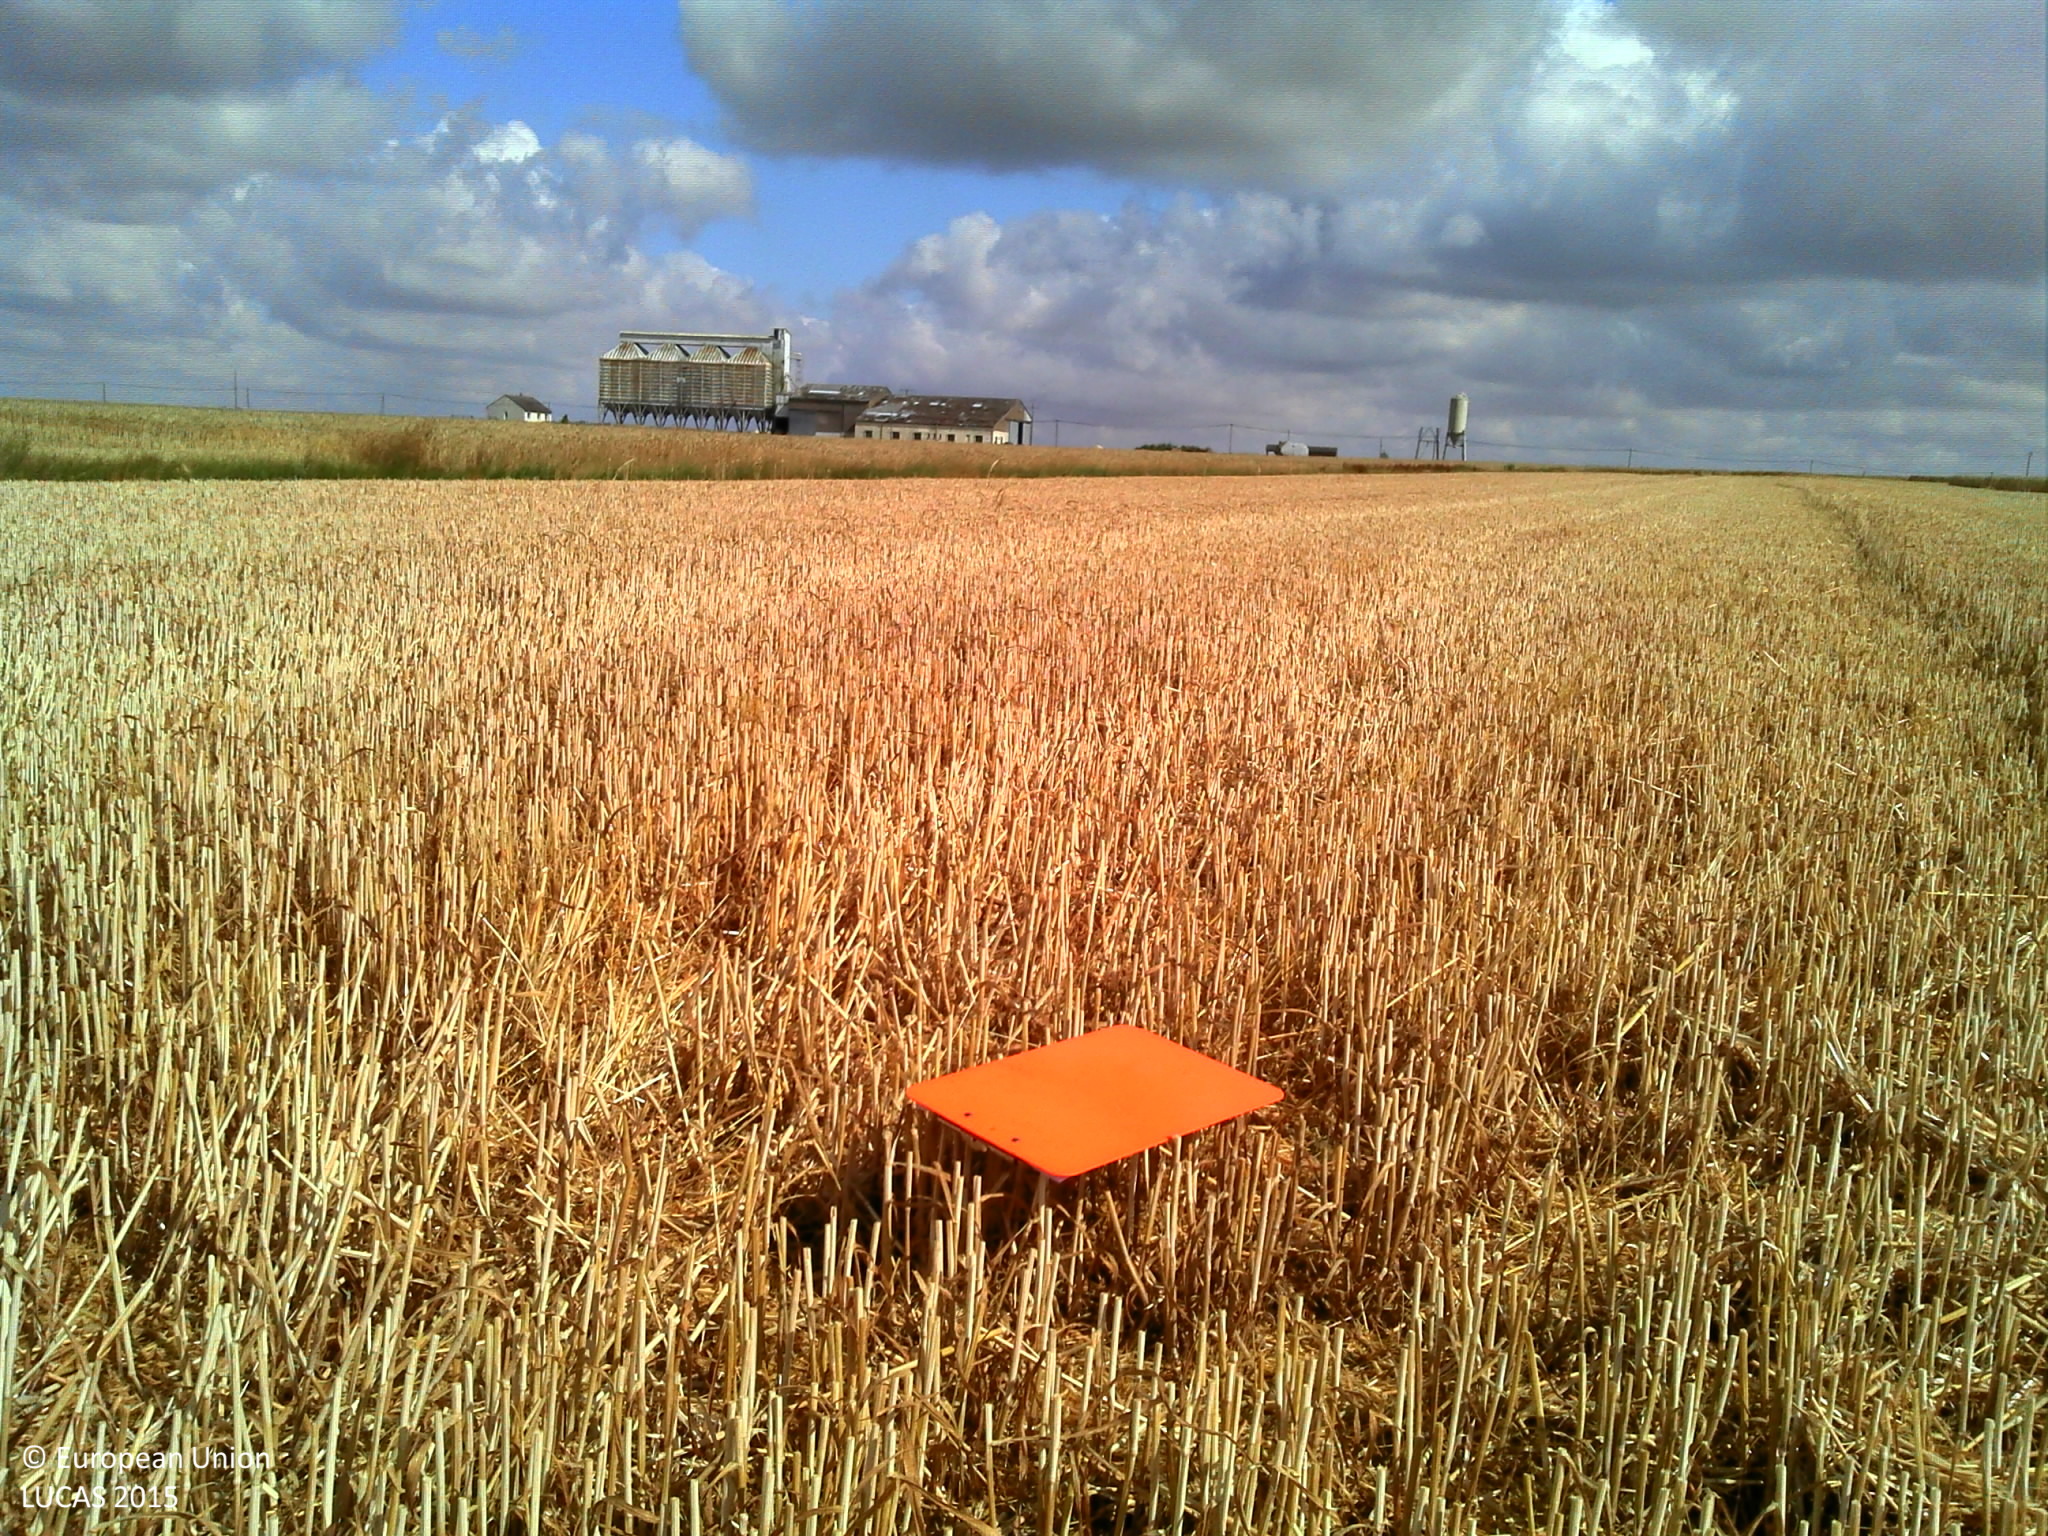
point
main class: Cropland
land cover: Common wheat
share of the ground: > 75 %
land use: Agriculture (excluding fallow land and kitchen gardens)
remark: Harvested field
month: July
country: FR
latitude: 48.5243
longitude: 1.2206
